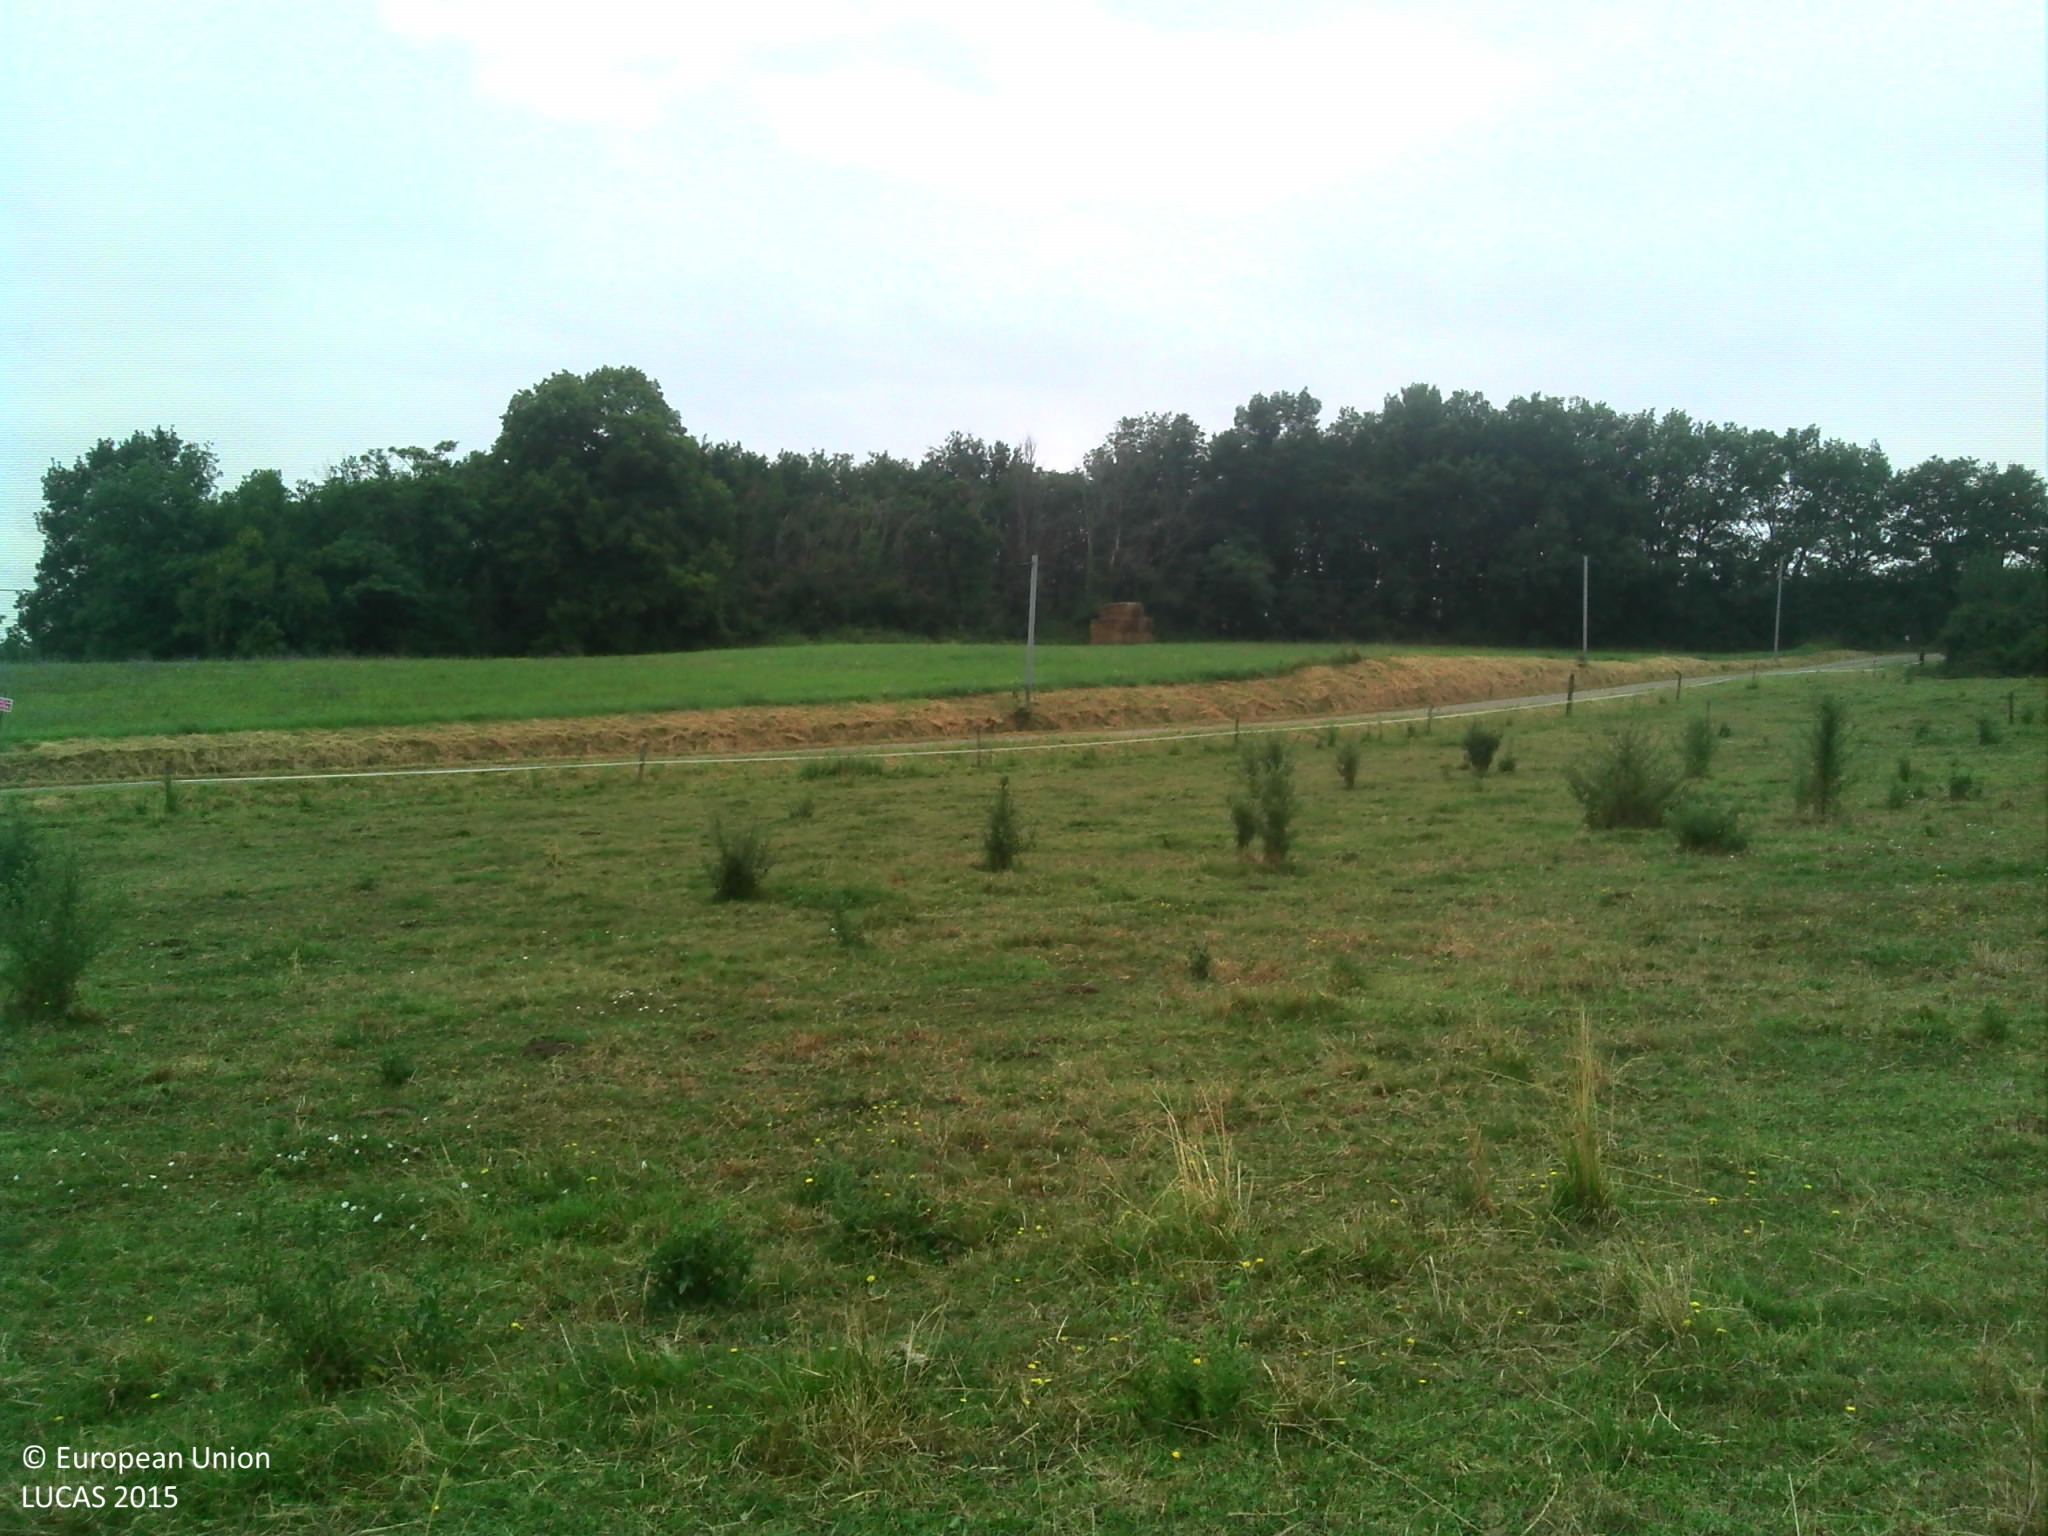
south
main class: Grassland
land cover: Grassland without tree/shrub cover
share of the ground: > 75 %
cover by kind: herbaceous plants 100 %
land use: Agriculture (excluding fallow land and kitchen gardens)
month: July
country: FR
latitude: 44.0250
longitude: 0.9274
